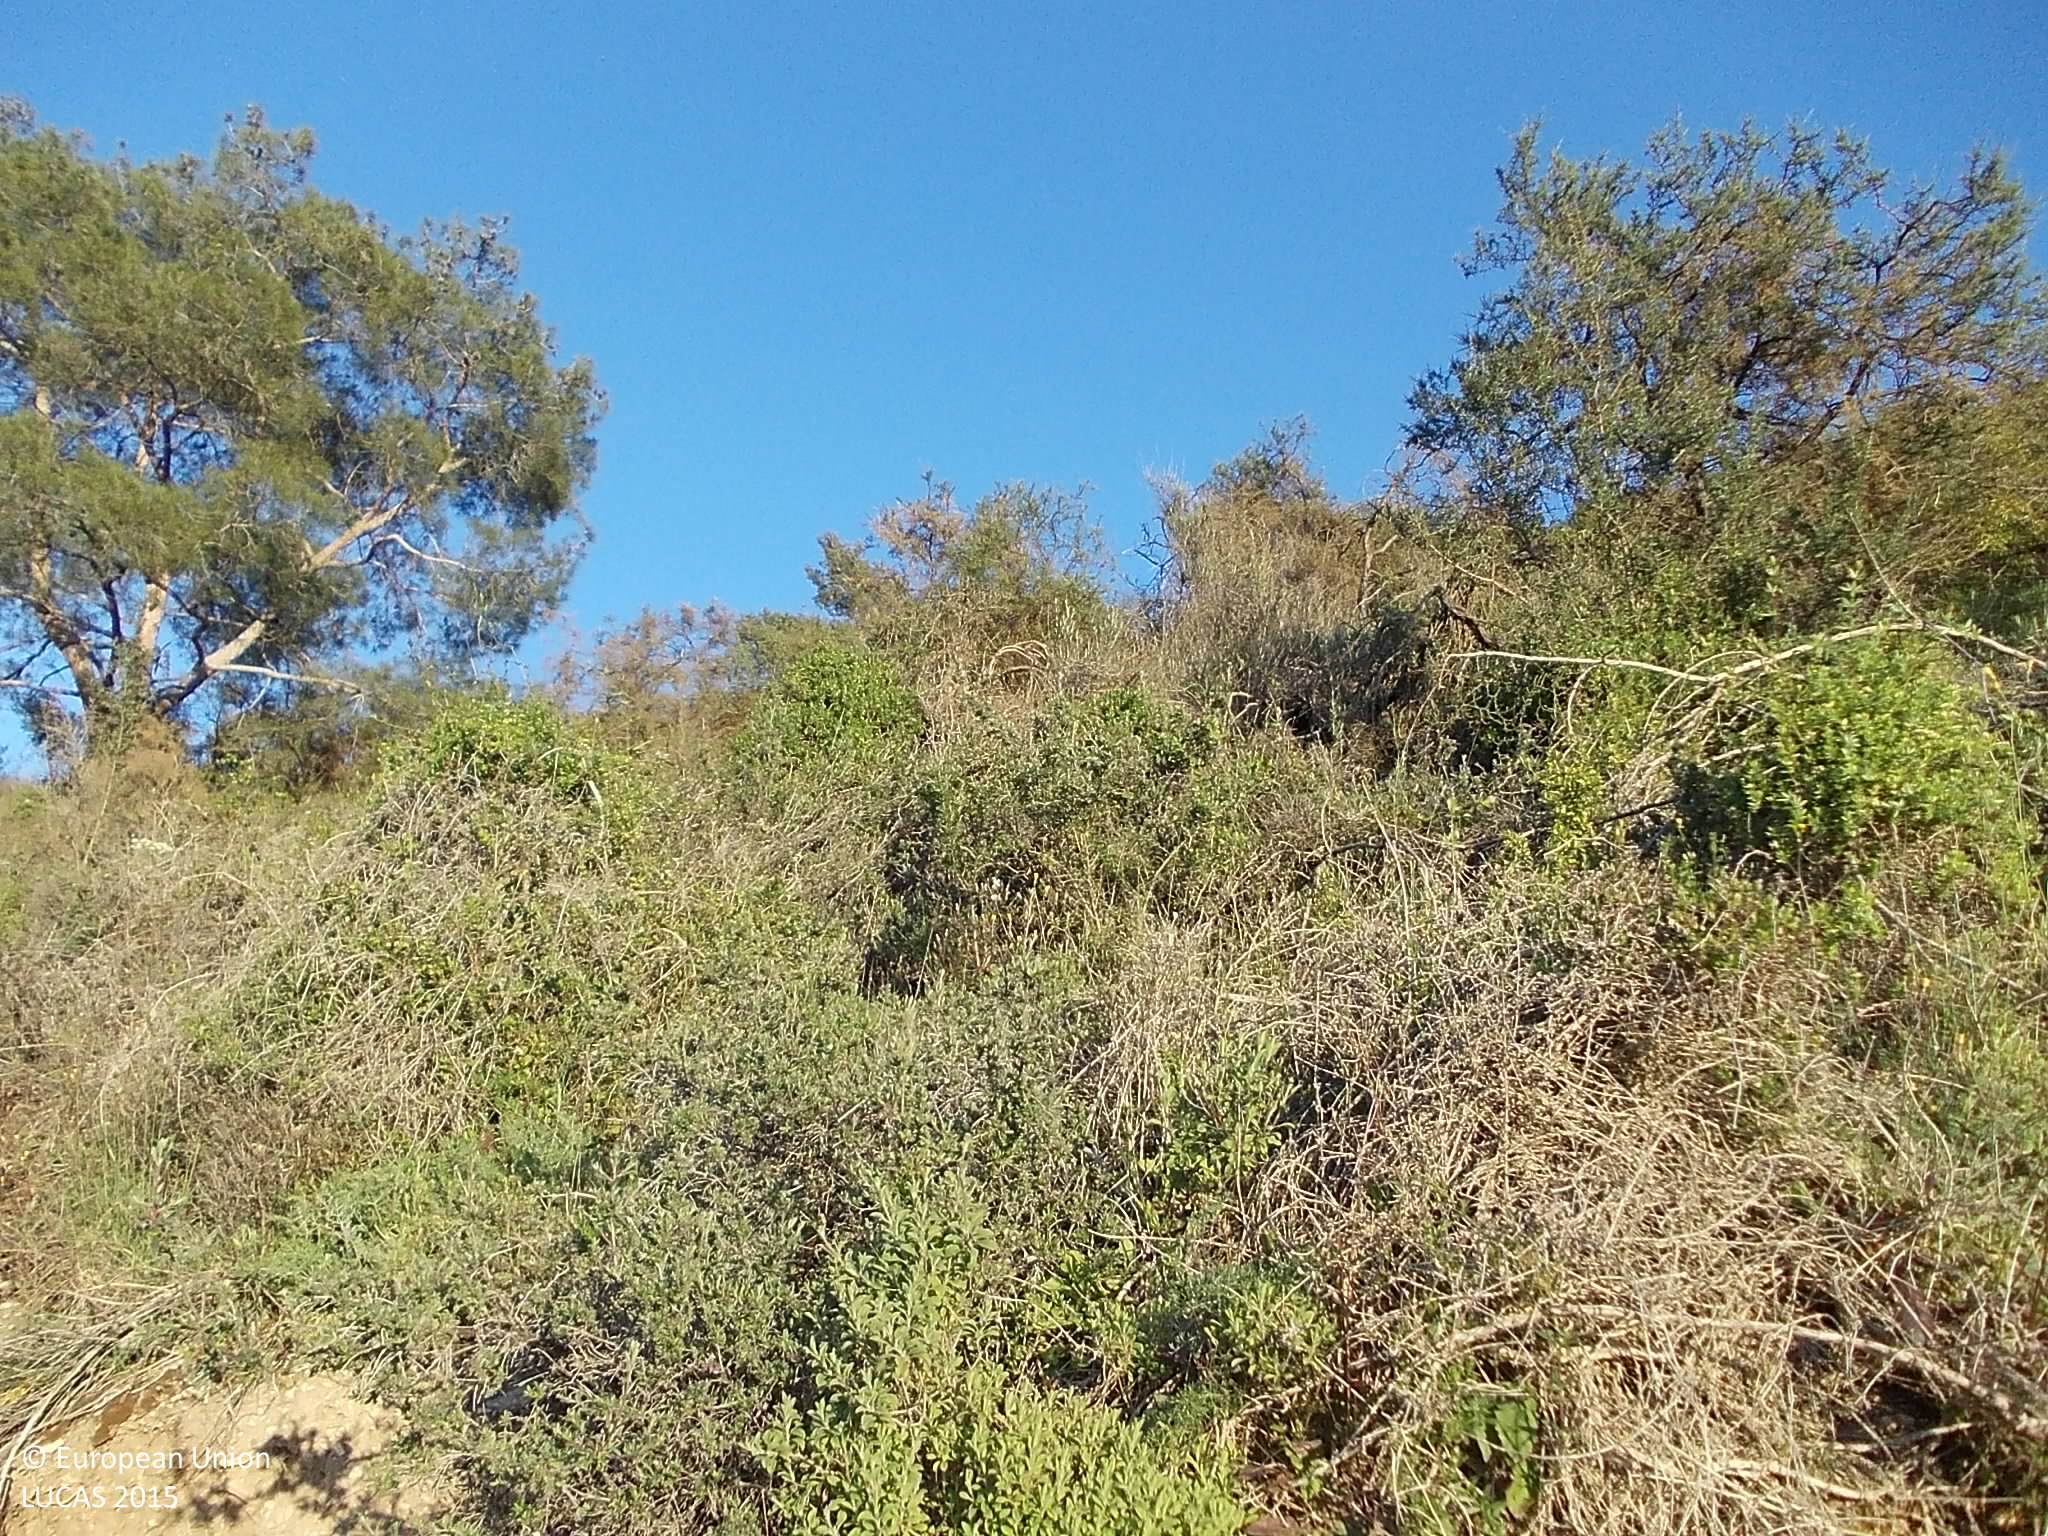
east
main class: Woodland
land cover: Pine dominated coniferous woodland
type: coniferous forest of the mediterranean region
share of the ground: 10 - 25 %
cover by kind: shrubs 65 %, unconsolidated bare surface 20 %, coniferous forest trees 15 %
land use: Forestry
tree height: > 5 m
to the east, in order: Pine dominated coniferous woodland
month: April
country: CY
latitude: 34.7890
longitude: 33.0196
